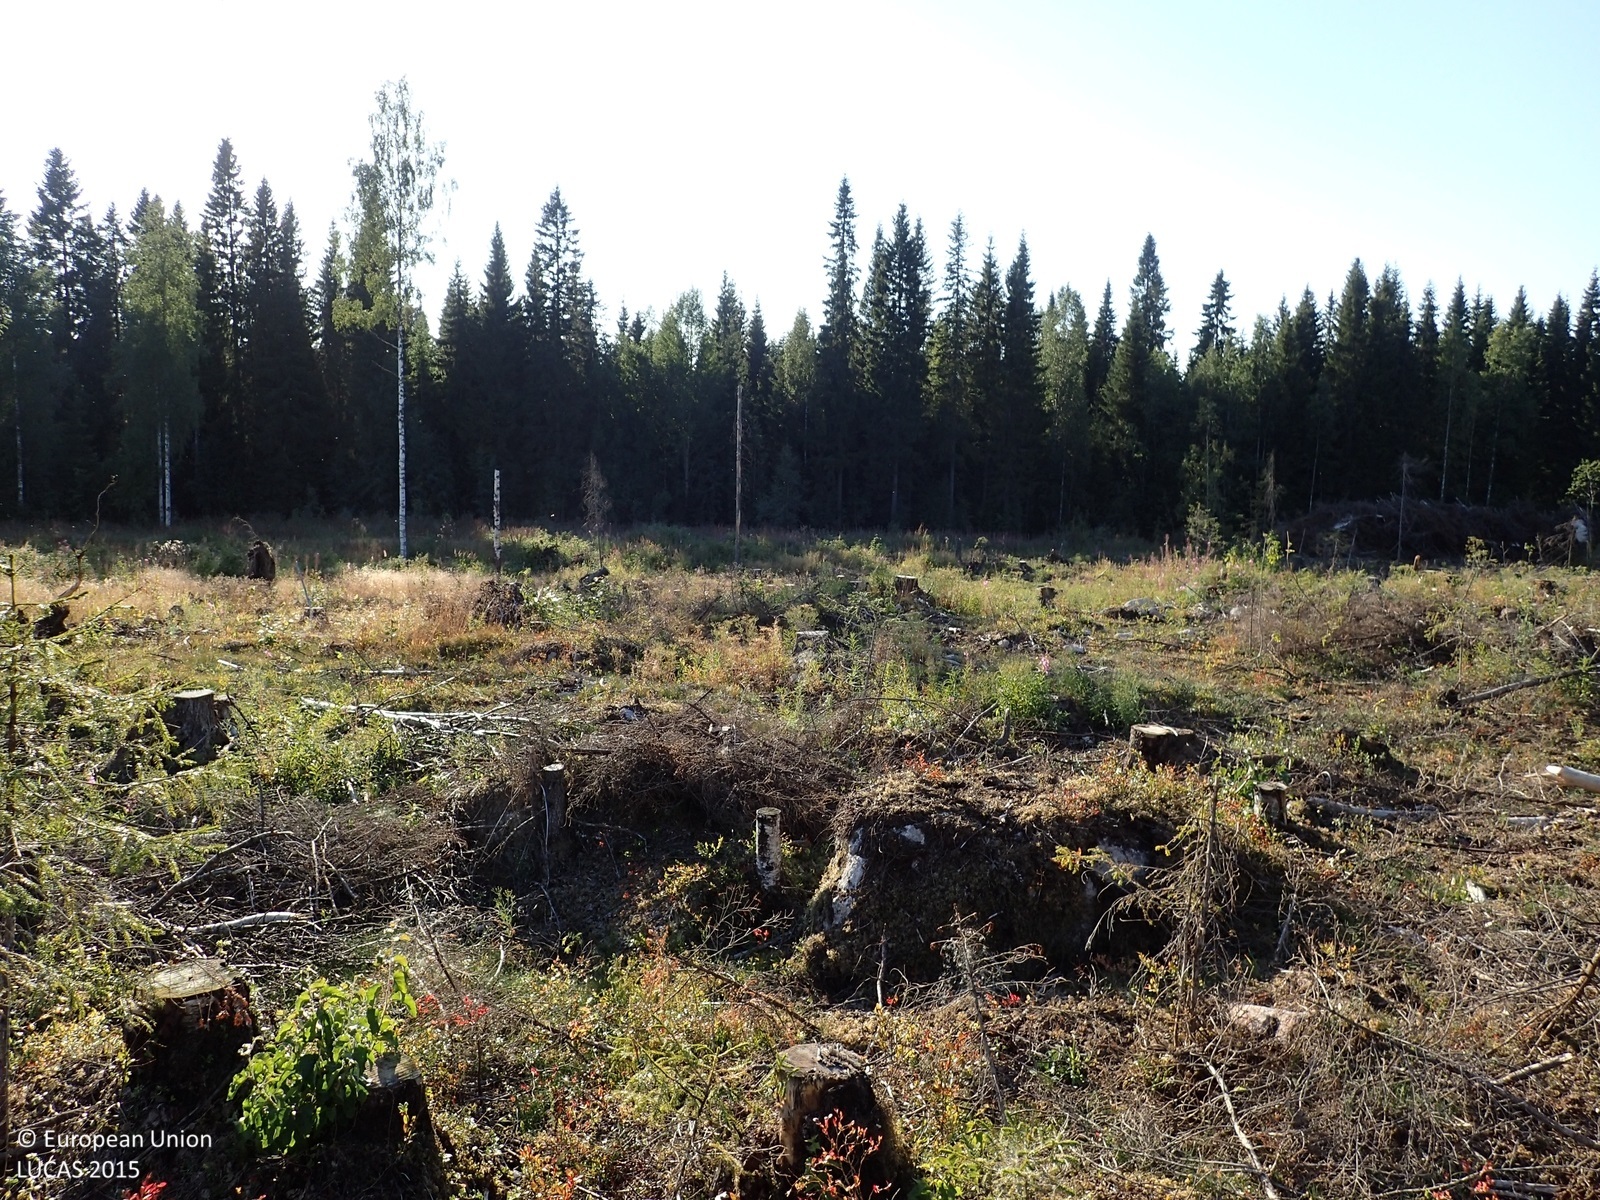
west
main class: Shrubland
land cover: Shrubland with sparse tree cover
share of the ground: 10 - 25 %
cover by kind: unconsolidated bare surface 40 %, lichens and mosses 20 %, shrubs 15 %, herbaceous plants 15 %, coniferous forest trees 5 %, consolidated bare surface 5 %
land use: Forestry
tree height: < 5 m
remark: Clear cut
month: August
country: FI
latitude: 62.4324
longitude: 21.8826
